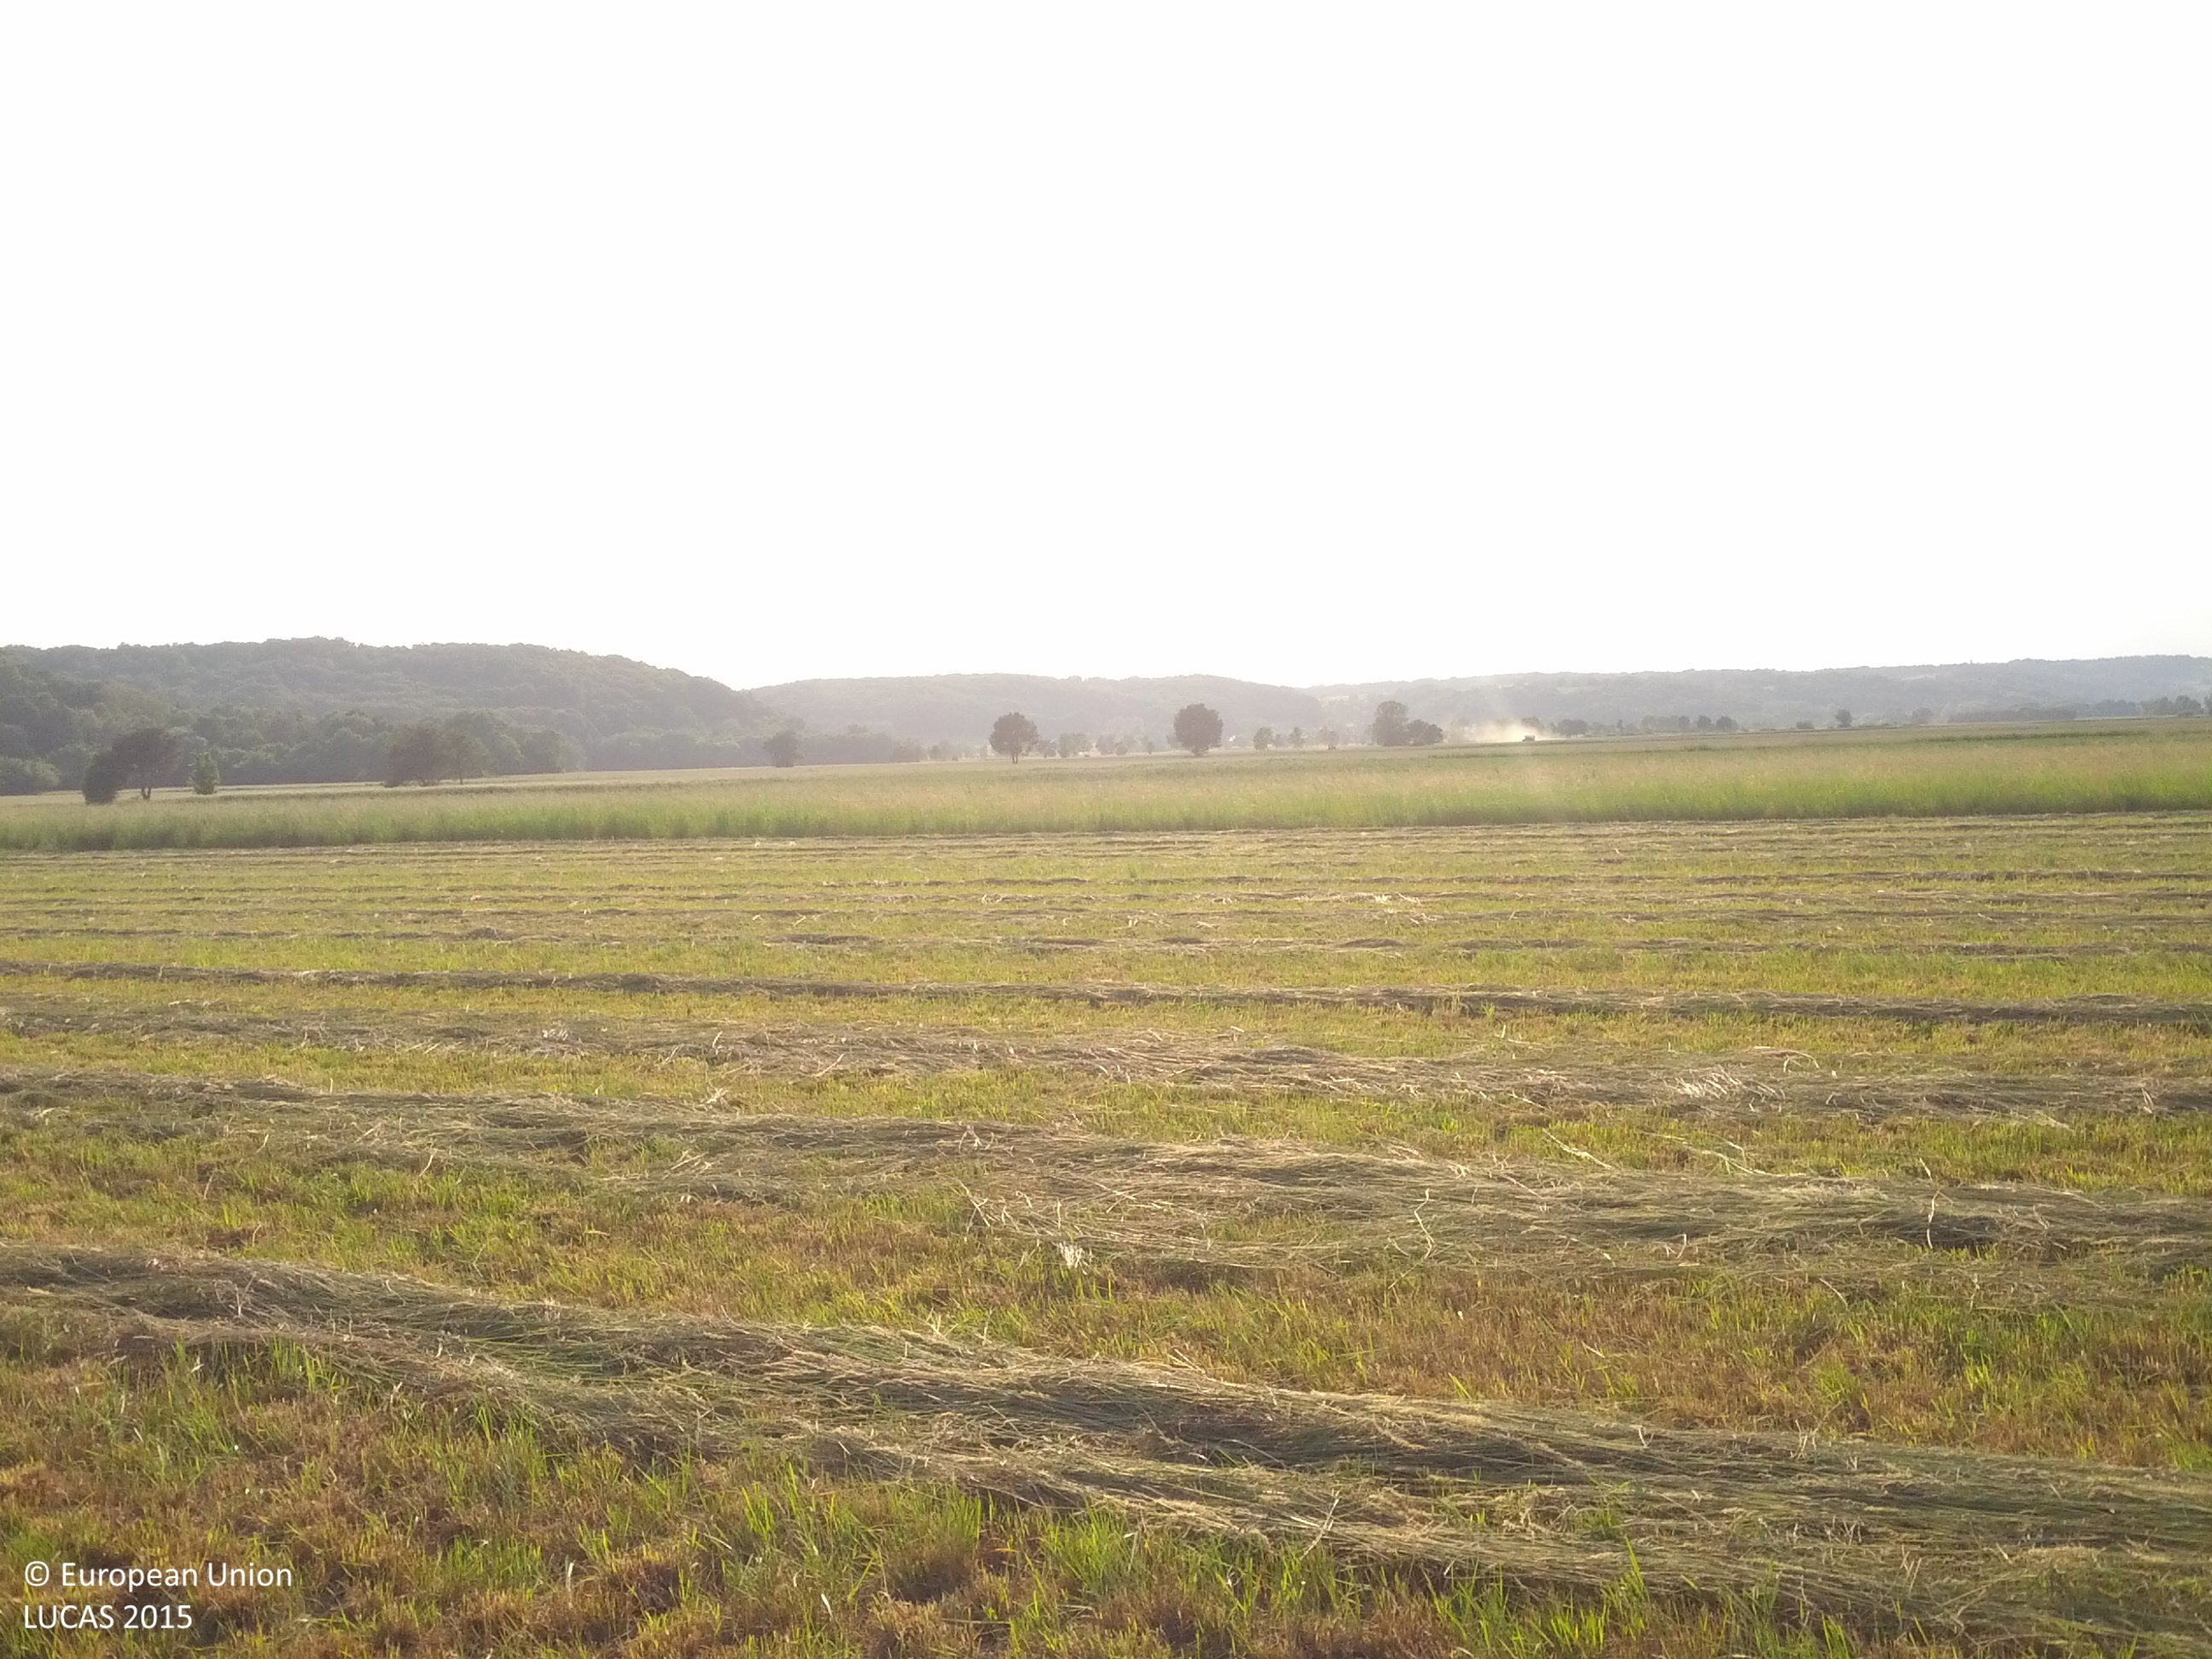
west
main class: Grassland
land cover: Grassland without tree/shrub cover
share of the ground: > 75 %
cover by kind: herbaceous plants 100 %
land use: Agriculture (excluding fallow land and kitchen gardens)
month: June
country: AT
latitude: 47.0049
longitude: 16.4602
